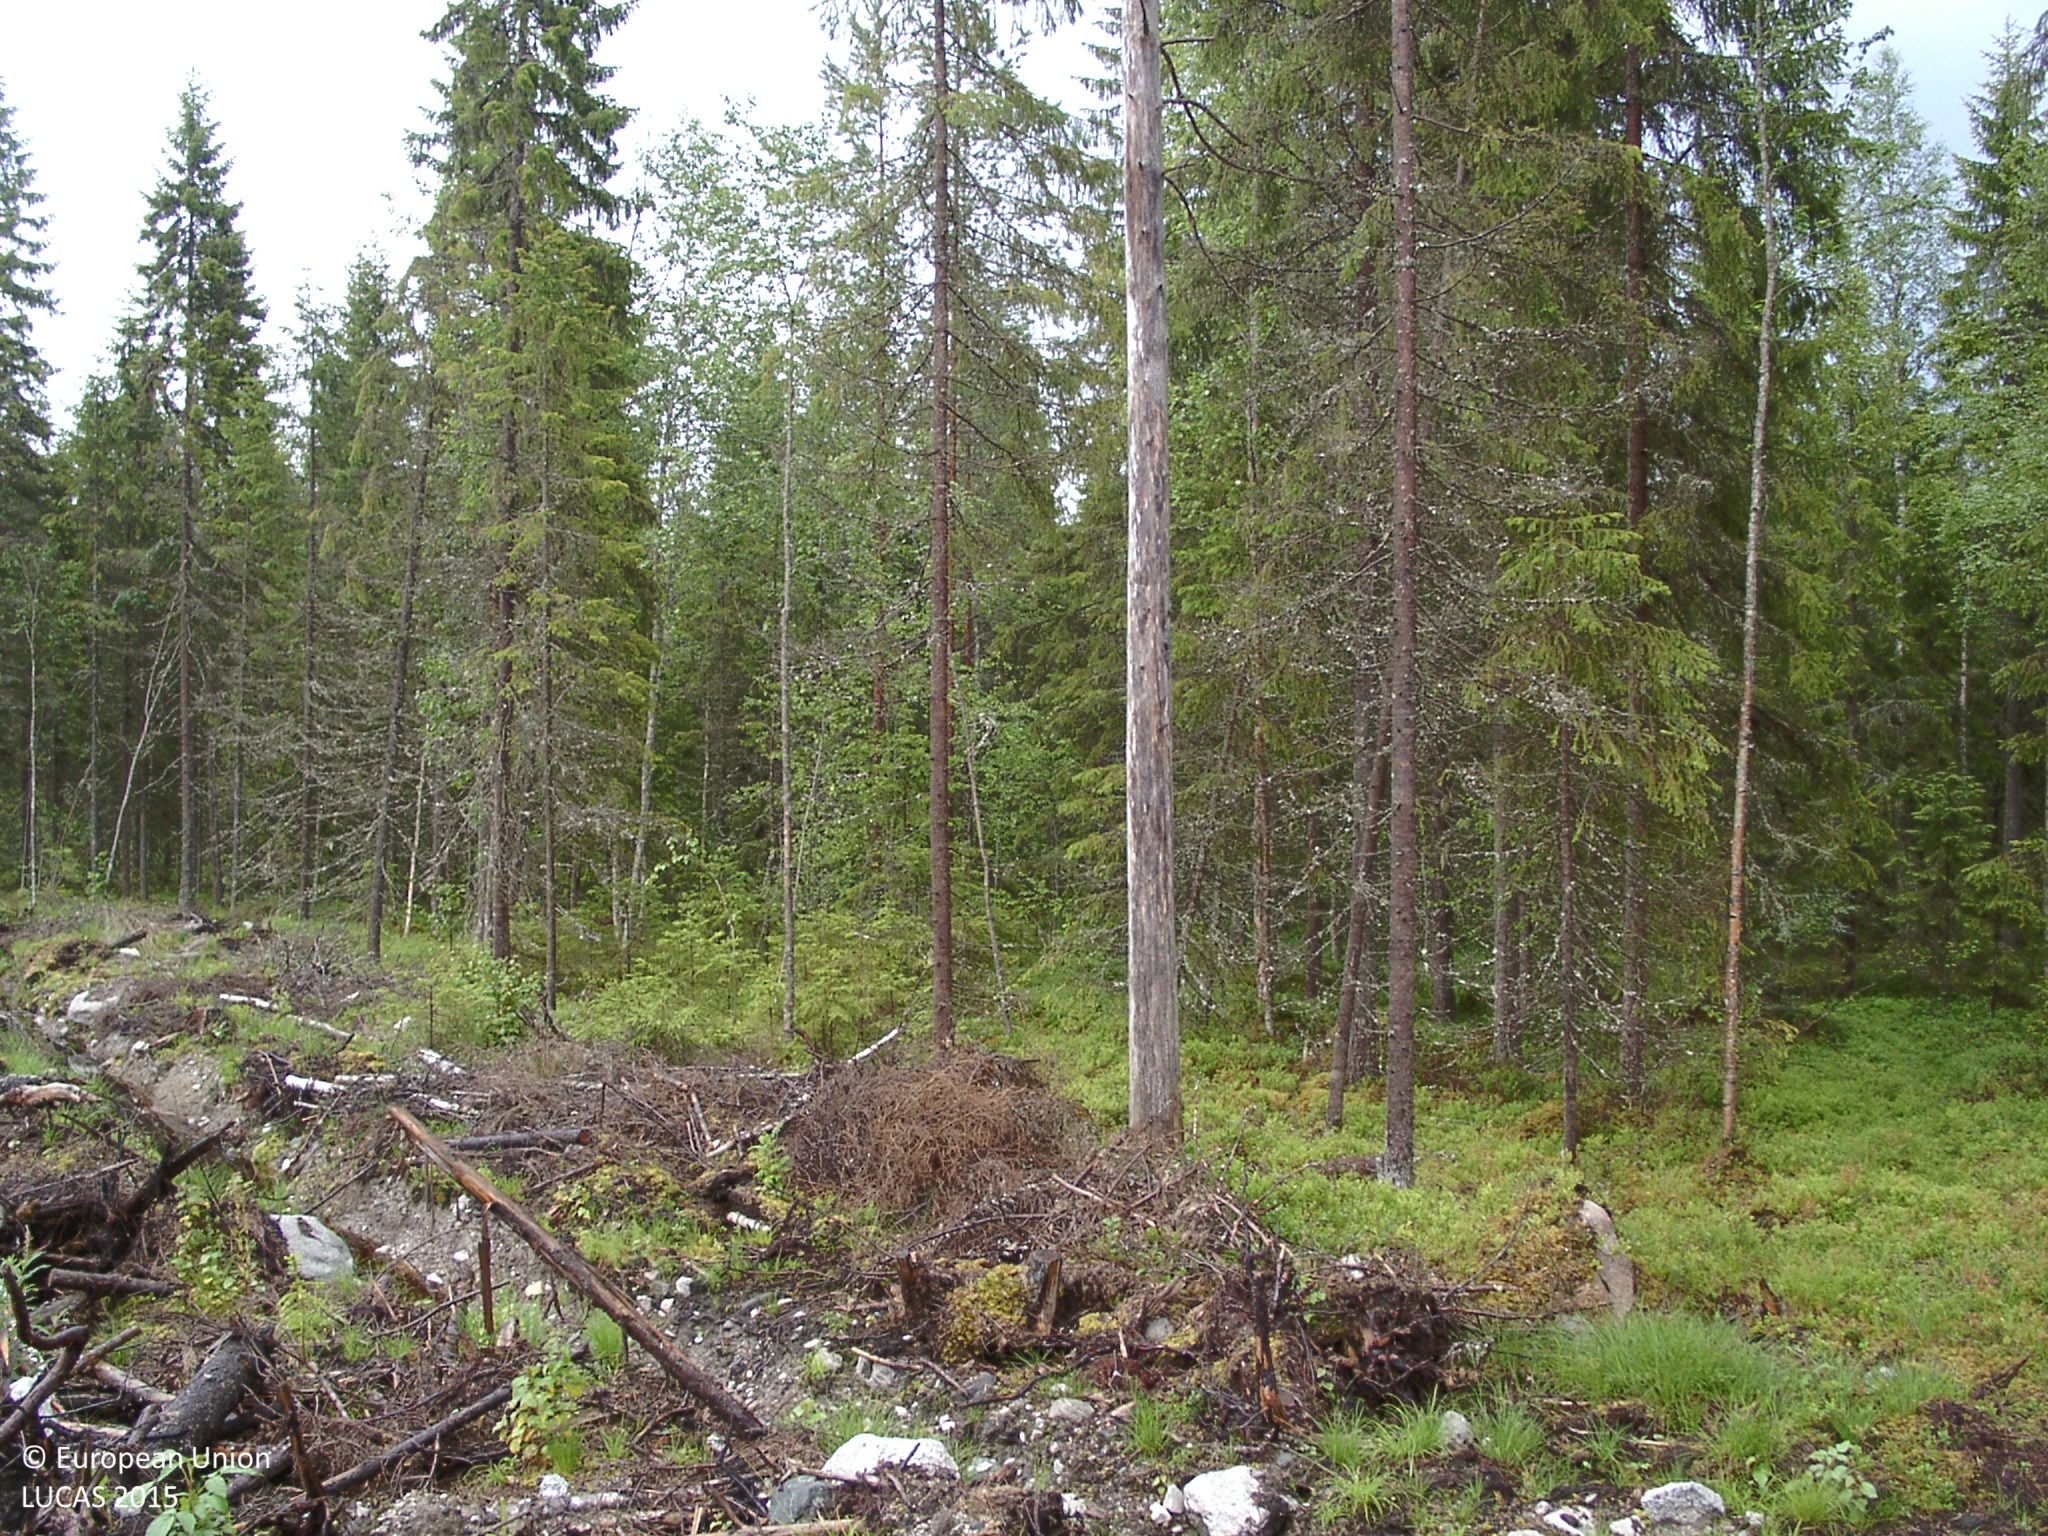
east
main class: Grassland
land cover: Grassland with sparse tree/shrub cover
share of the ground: 25 - 50 %
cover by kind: herbaceous plants 25 %, unconsolidated bare surface 25 %, lichens and mosses 10 %, broadleaved forest trees 5 %
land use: Forestry
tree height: < 5 m
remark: Nursery
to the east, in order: Grassland with sparse tree/shrub cover; Ditches and canals; Spruce dominated mixed woodland; Tracks; Other coniferous woodland; Grass margins; Other mixed woodland; Groves
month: August
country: FI
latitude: 62.8128
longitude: 24.6264
